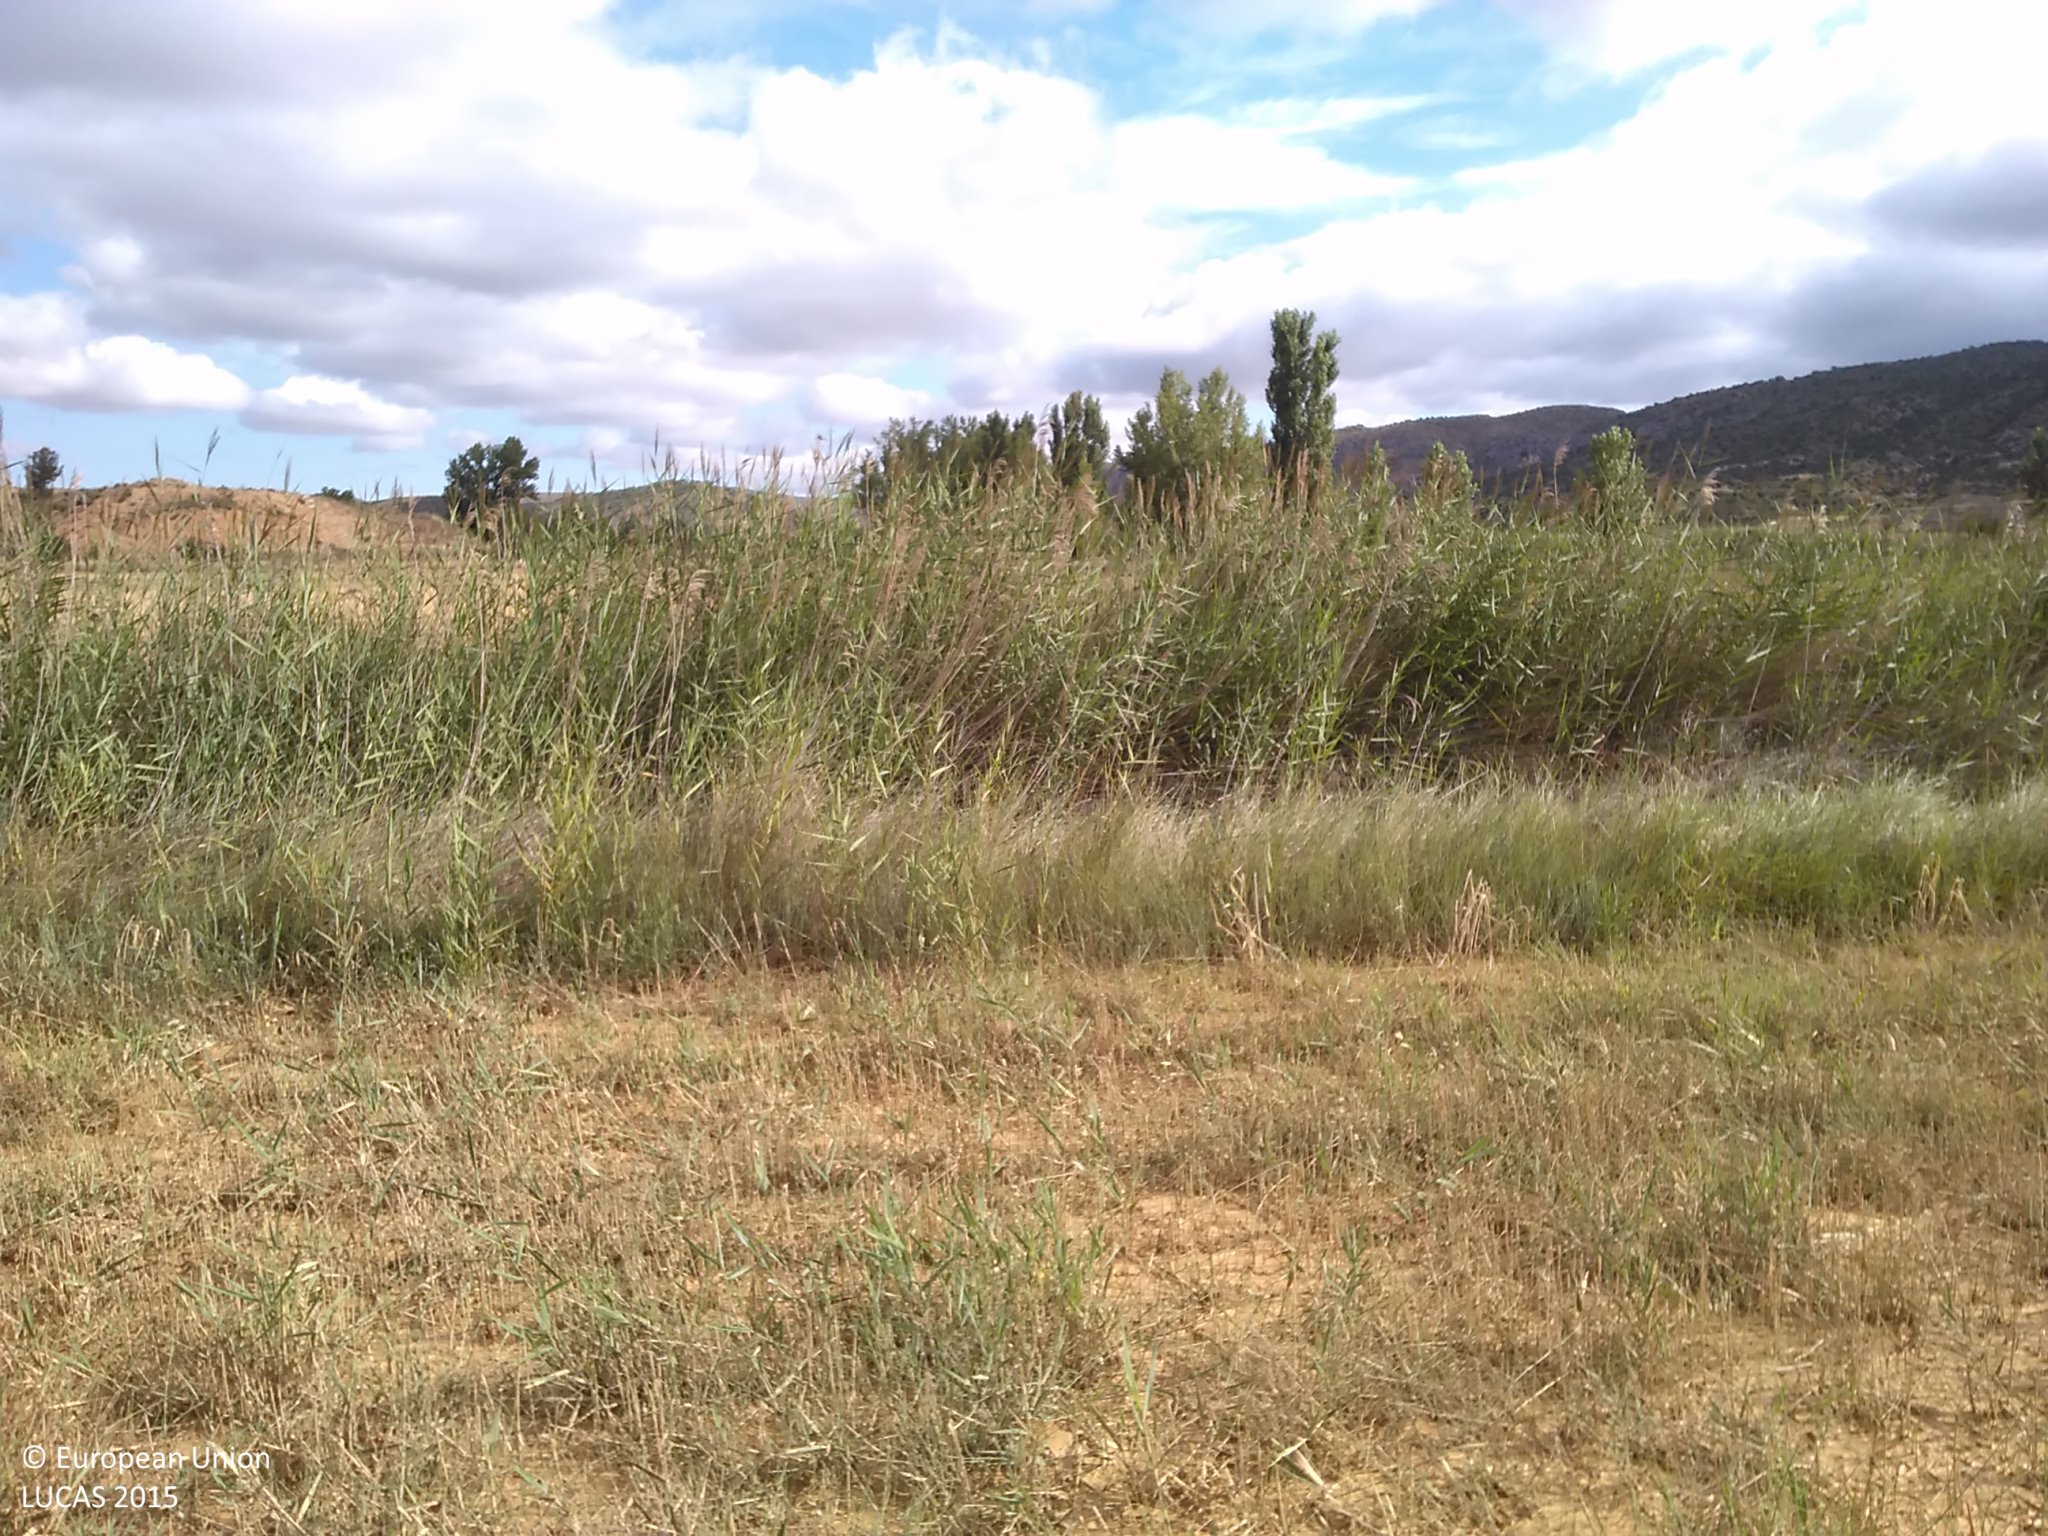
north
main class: Cropland
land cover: Barley
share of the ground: < 10 %
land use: Agriculture (excluding fallow land and kitchen gardens)
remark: Harvested field
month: July
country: ES
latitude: 41.3399
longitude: -1.9663
